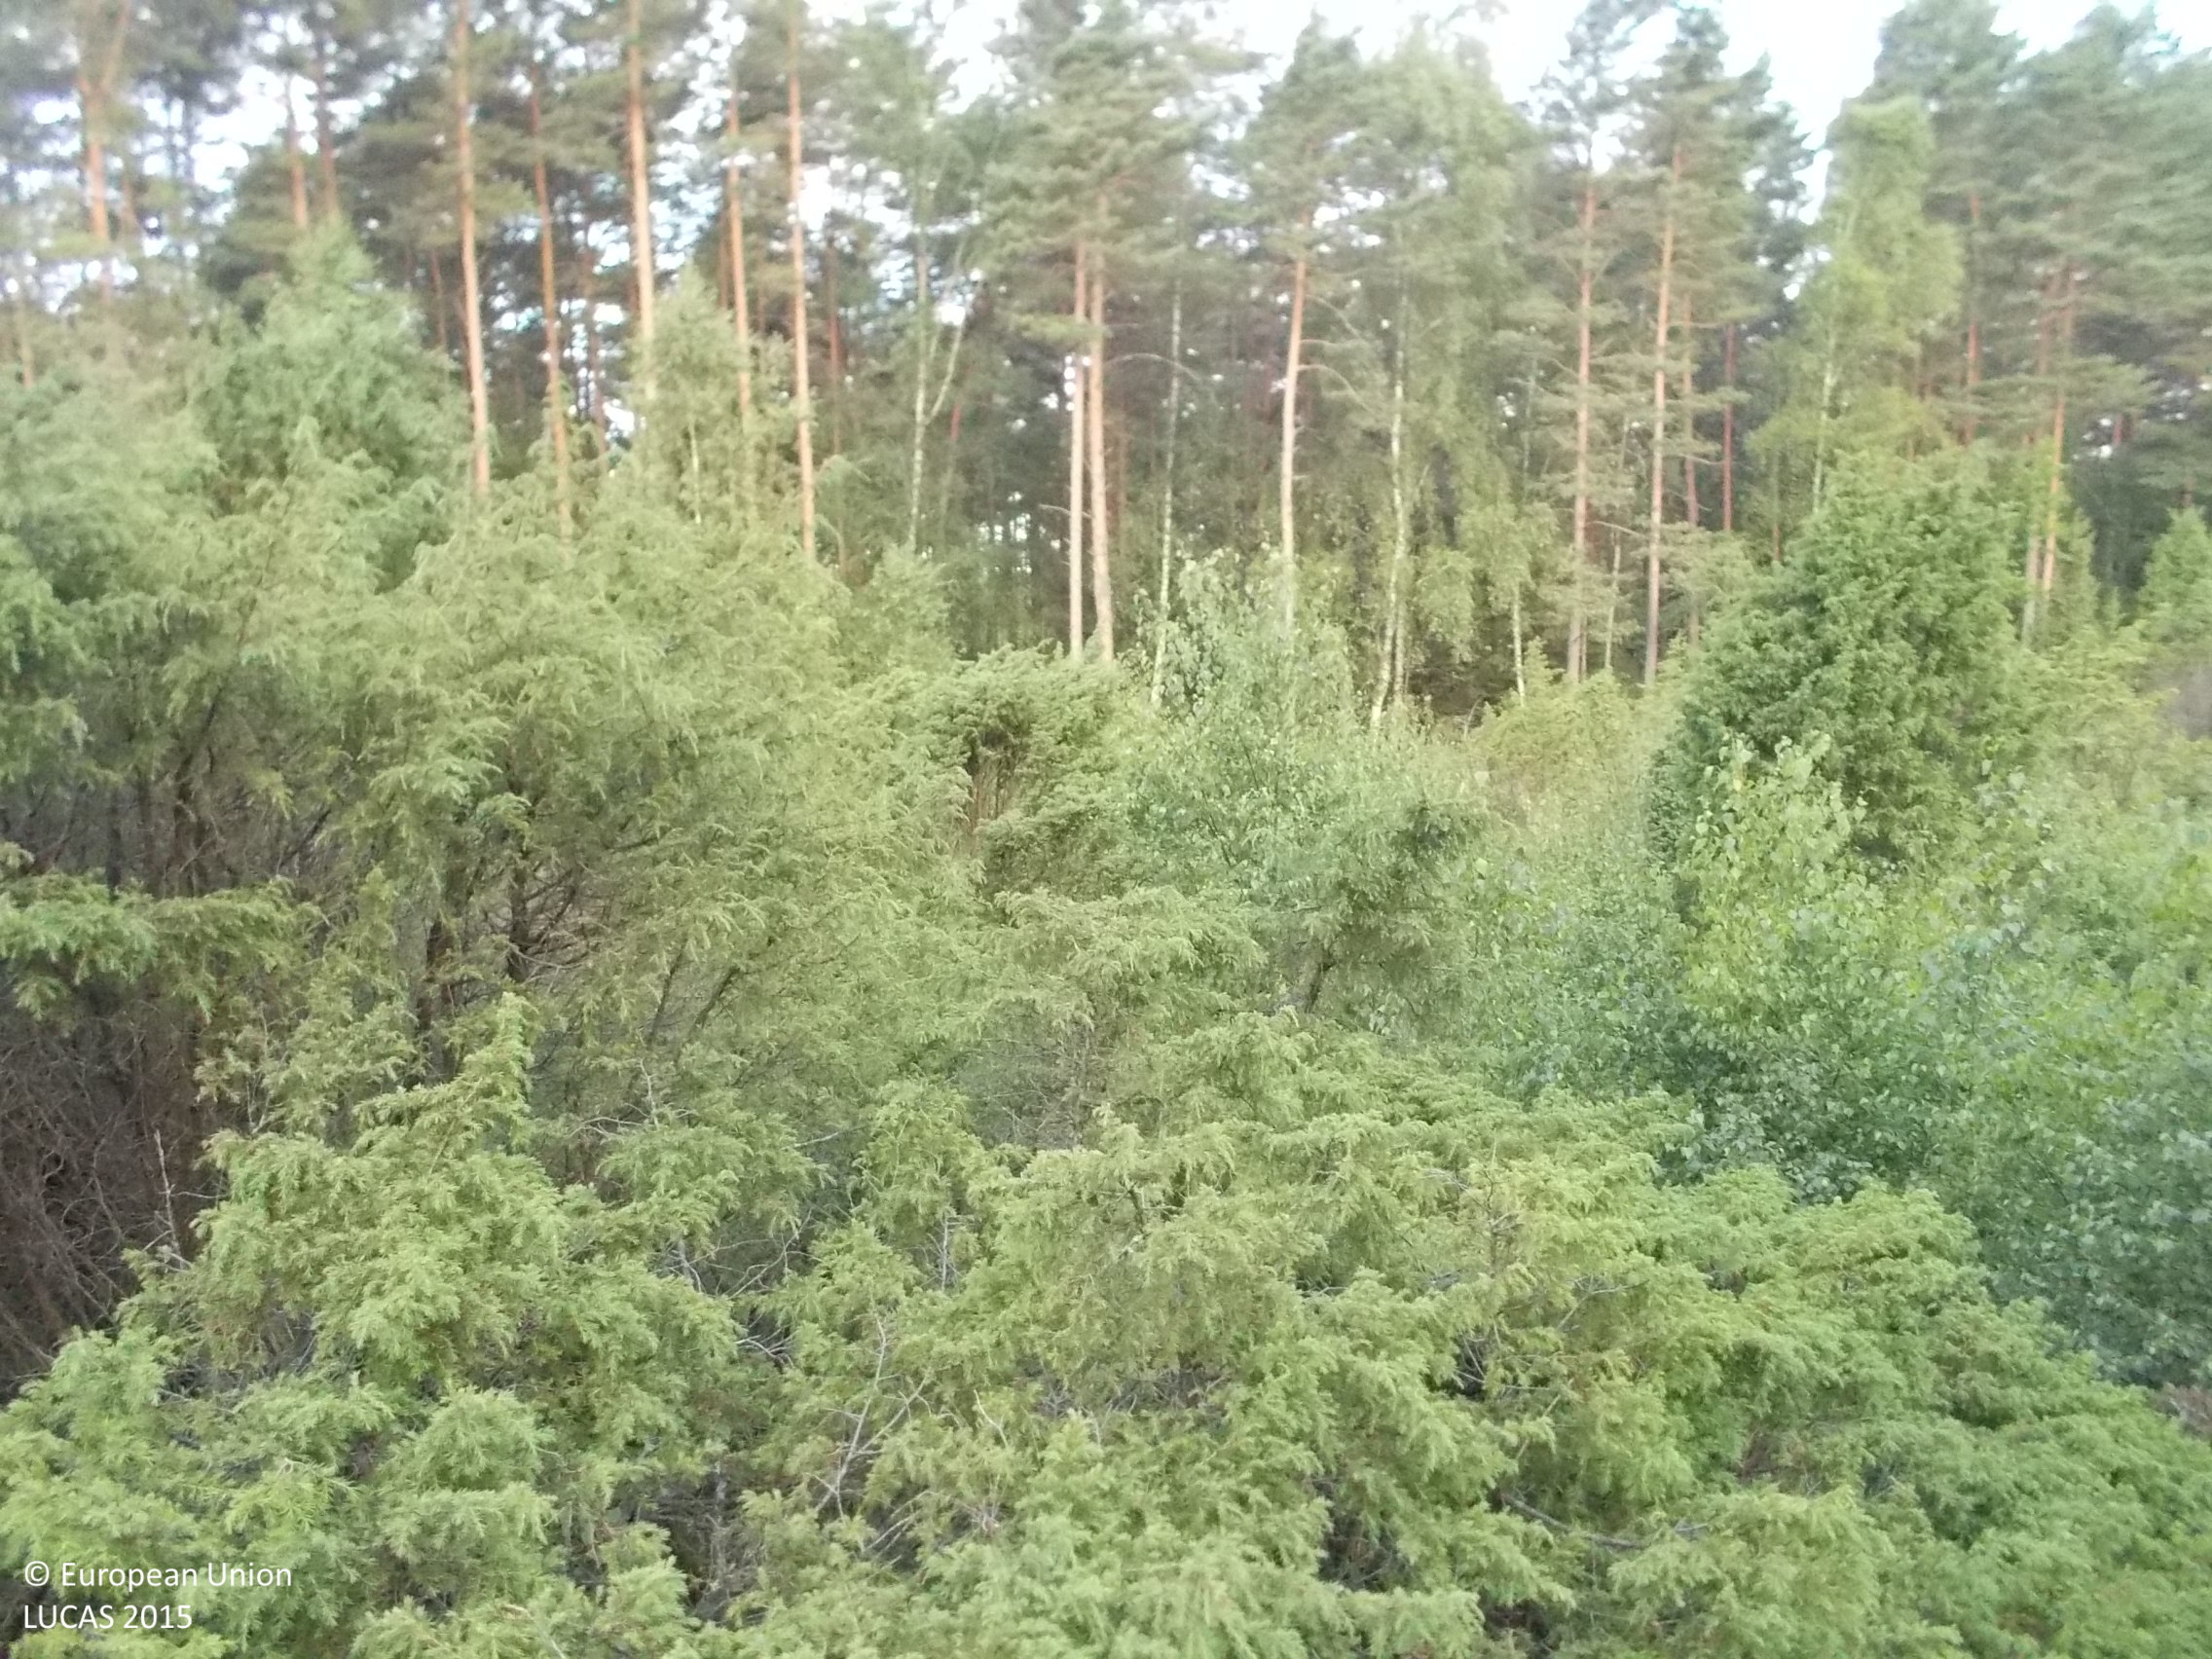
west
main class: Shrubland
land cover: Shrubland with sparse tree cover
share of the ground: > 75 %
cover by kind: shrubs 70 %, herbaceous plants 10 %, lichens and mosses 10 %, broadleaved forest trees 5 %, consolidated bare surface 5 %
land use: Electricity, gas and thermal power distribution
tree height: < 5 m
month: July
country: SE
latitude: 57.1930
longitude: 12.2639
